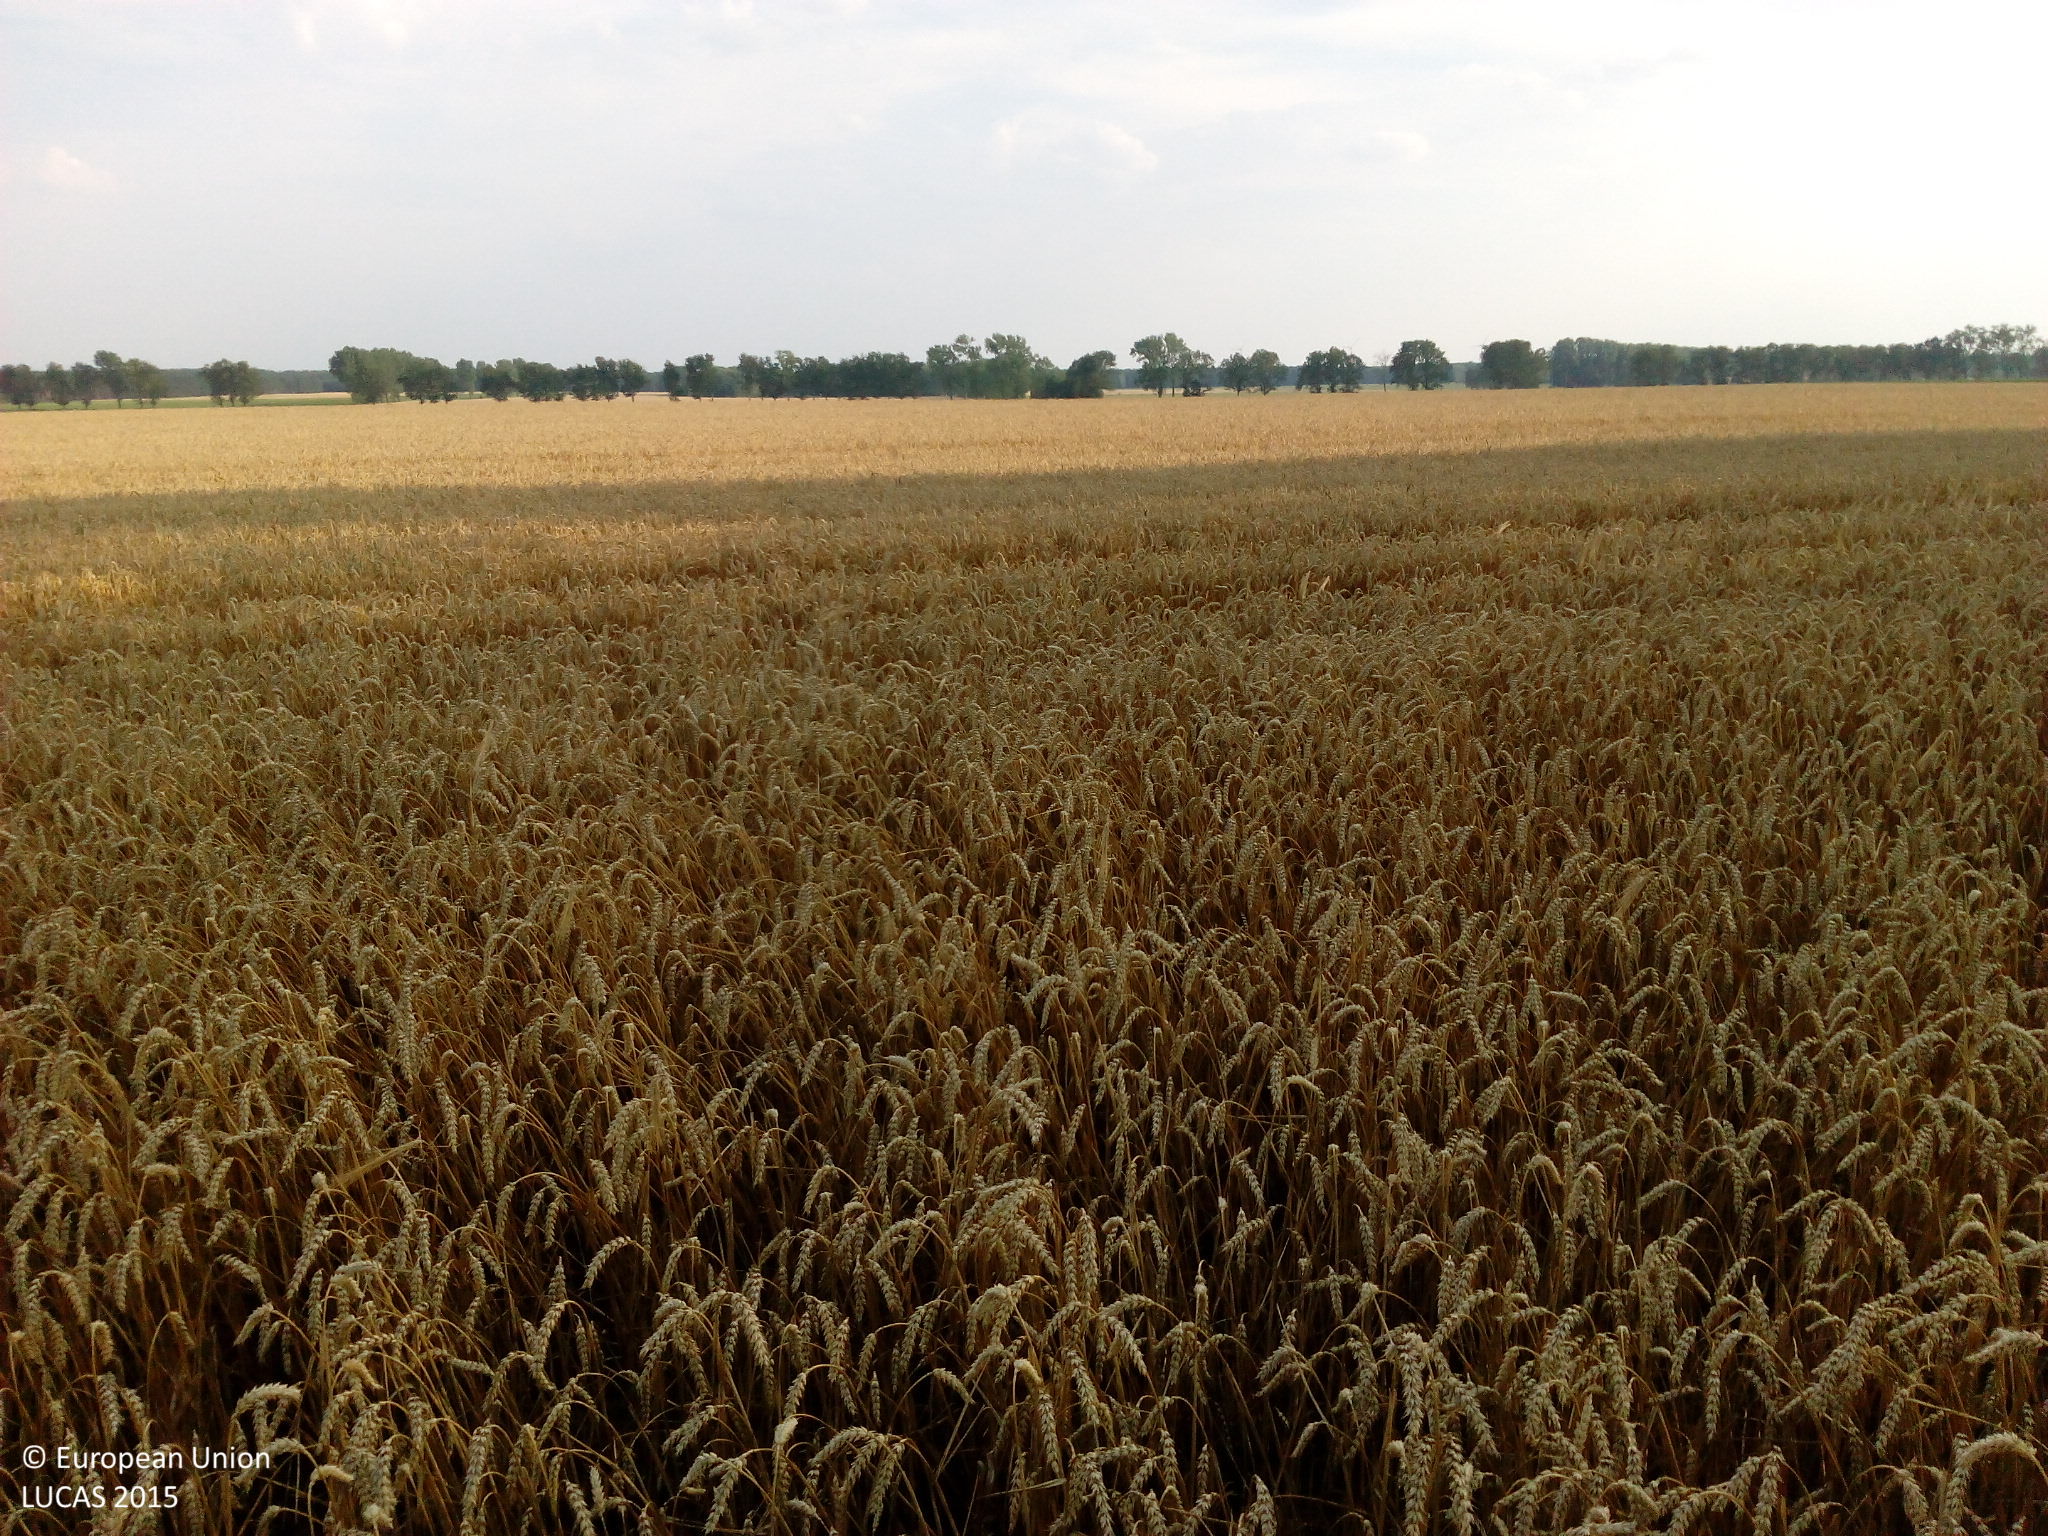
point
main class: Cropland
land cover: Common wheat
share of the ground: > 75 %
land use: Agriculture (excluding fallow land and kitchen gardens)
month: August
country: DE
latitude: 51.9039
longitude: 13.1541
